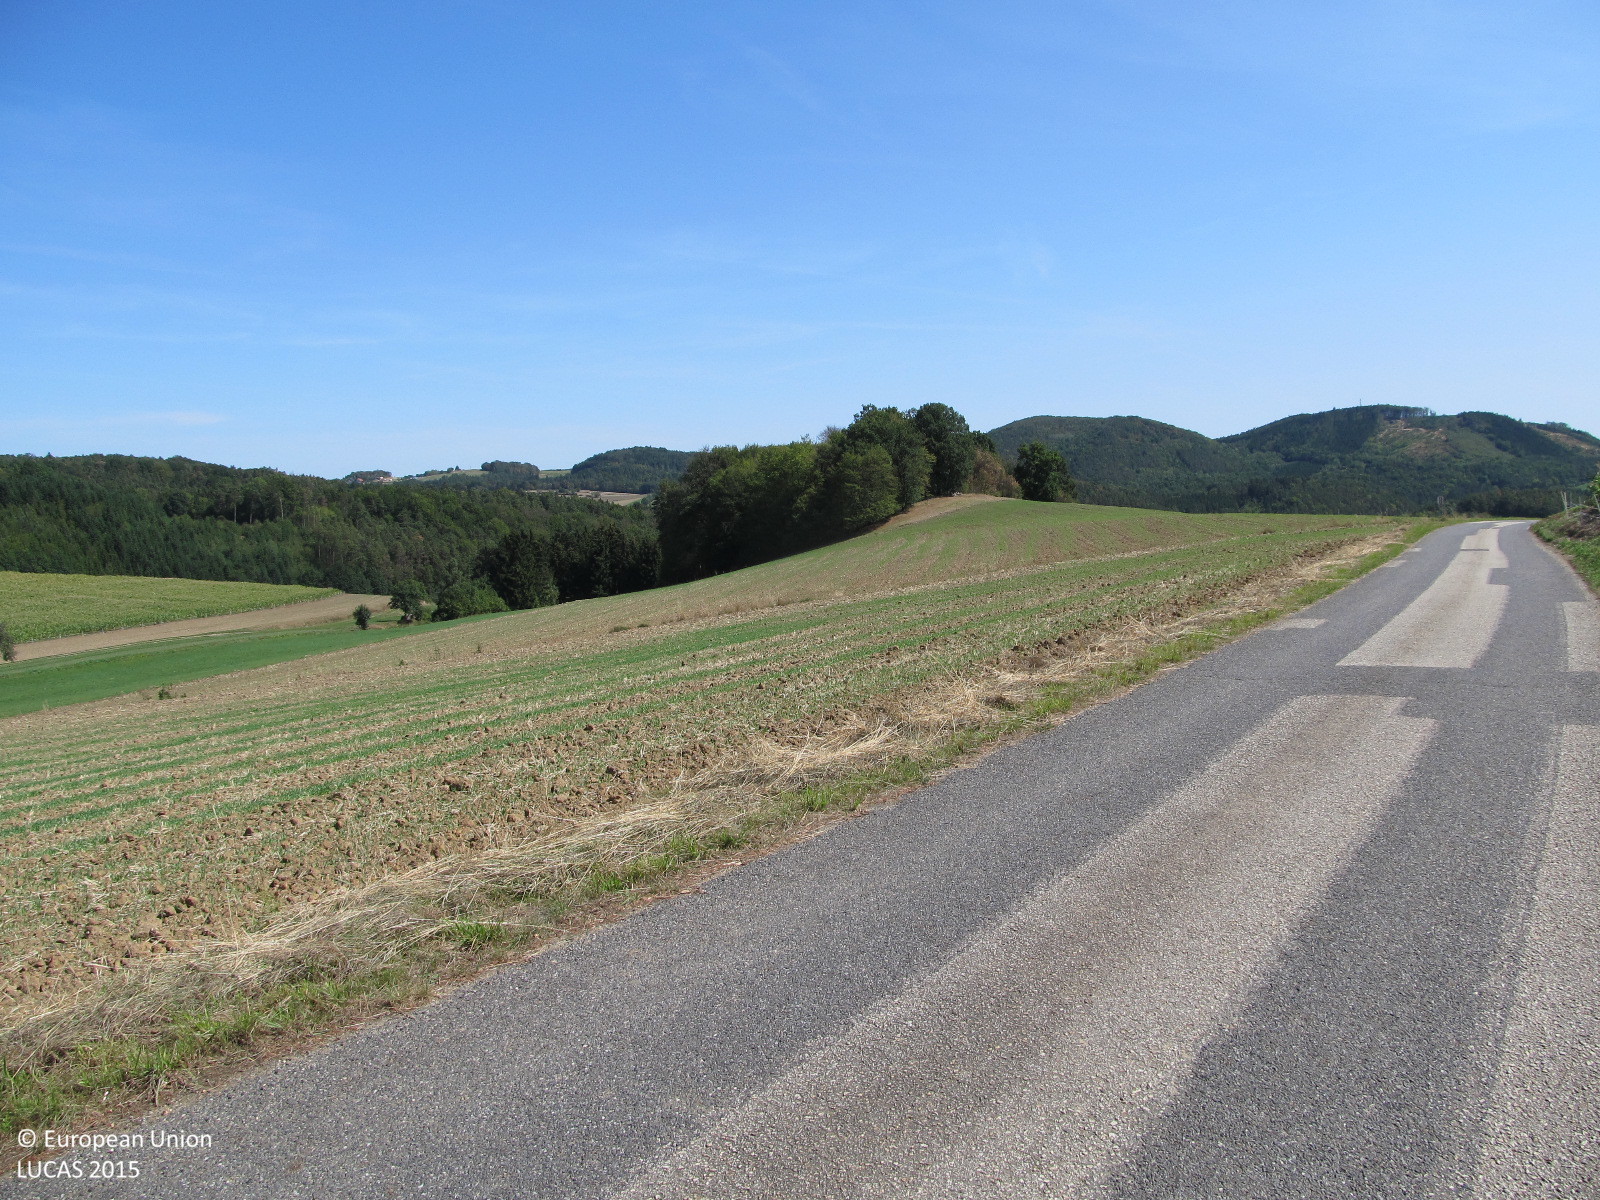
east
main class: Cropland
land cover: Maize
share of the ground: > 75 %
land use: Agriculture (excluding fallow land and kitchen gardens)
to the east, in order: Maize; Fences; Grassland with sparse tree/shrub cover; Tracks; Common wheat
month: August
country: AT
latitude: 48.5032
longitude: 15.4571
